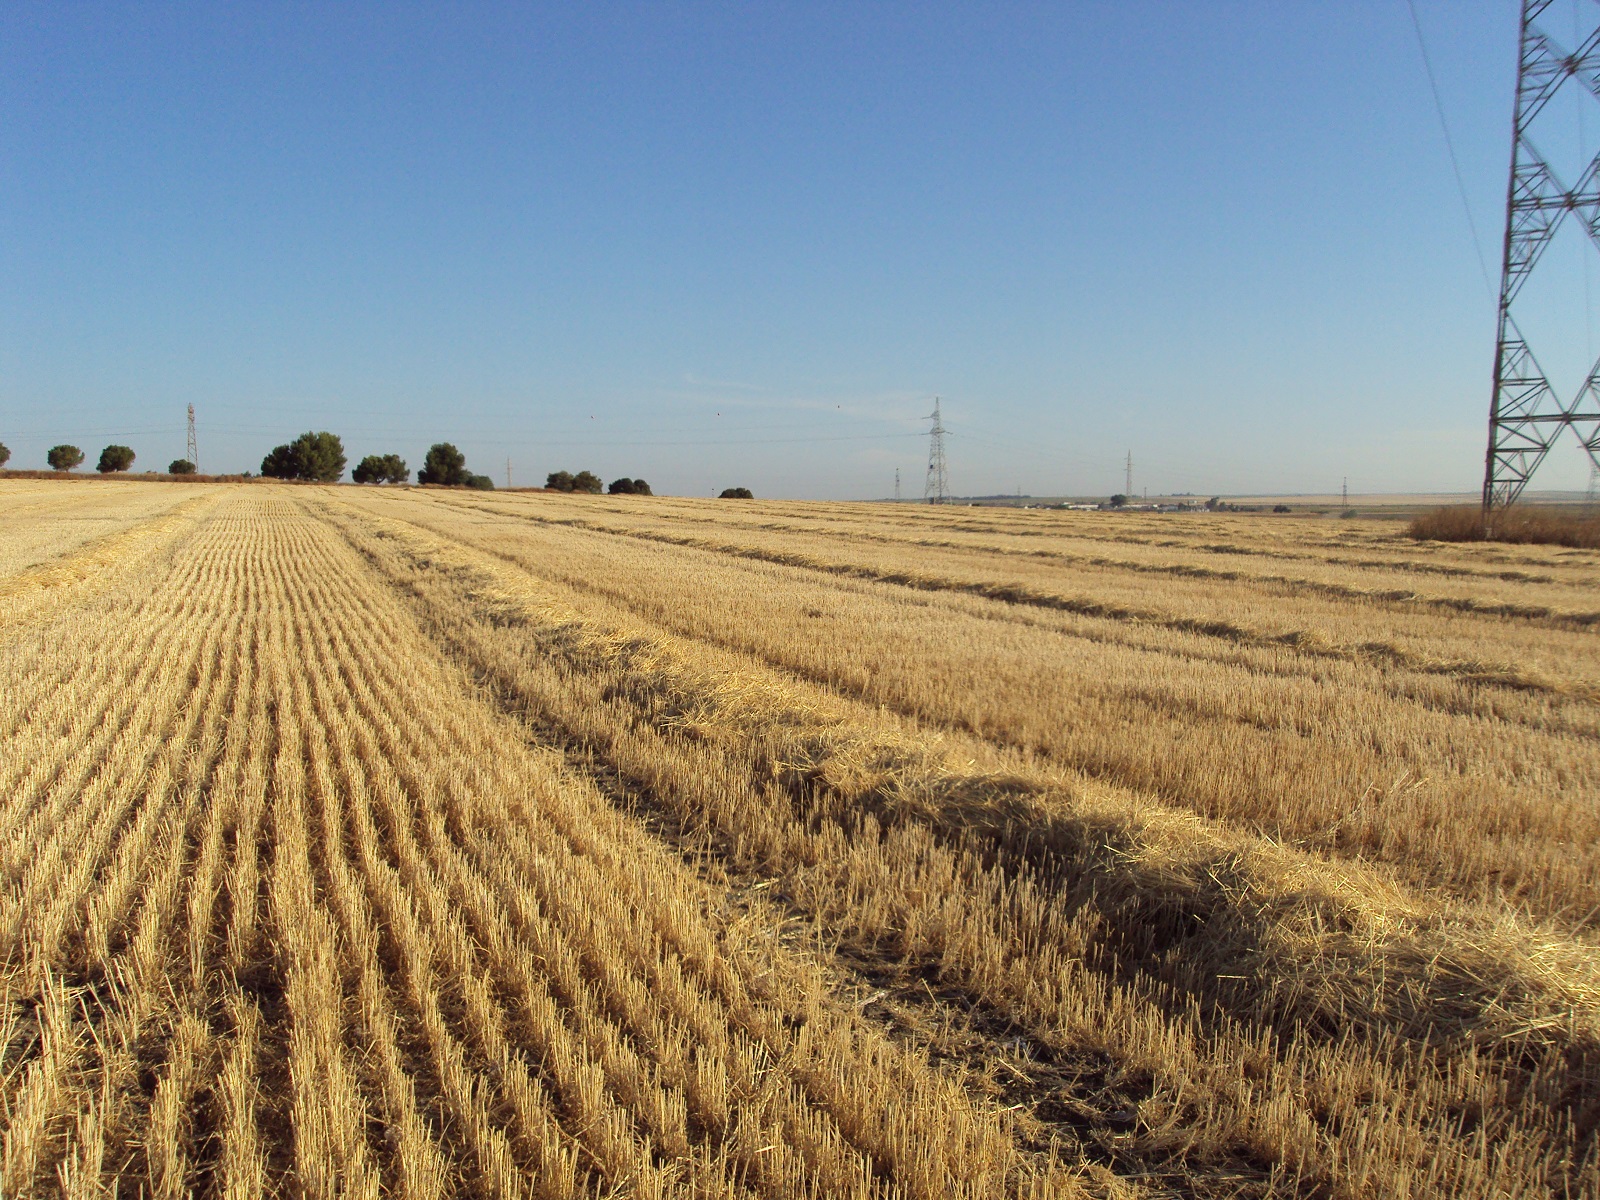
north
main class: Cropland
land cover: Durum wheat
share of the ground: > 75 %
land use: Agriculture (excluding fallow land and kitchen gardens)
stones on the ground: < 10 %
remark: Harvested field
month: June
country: ES
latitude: 37.2940
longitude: -6.9026
